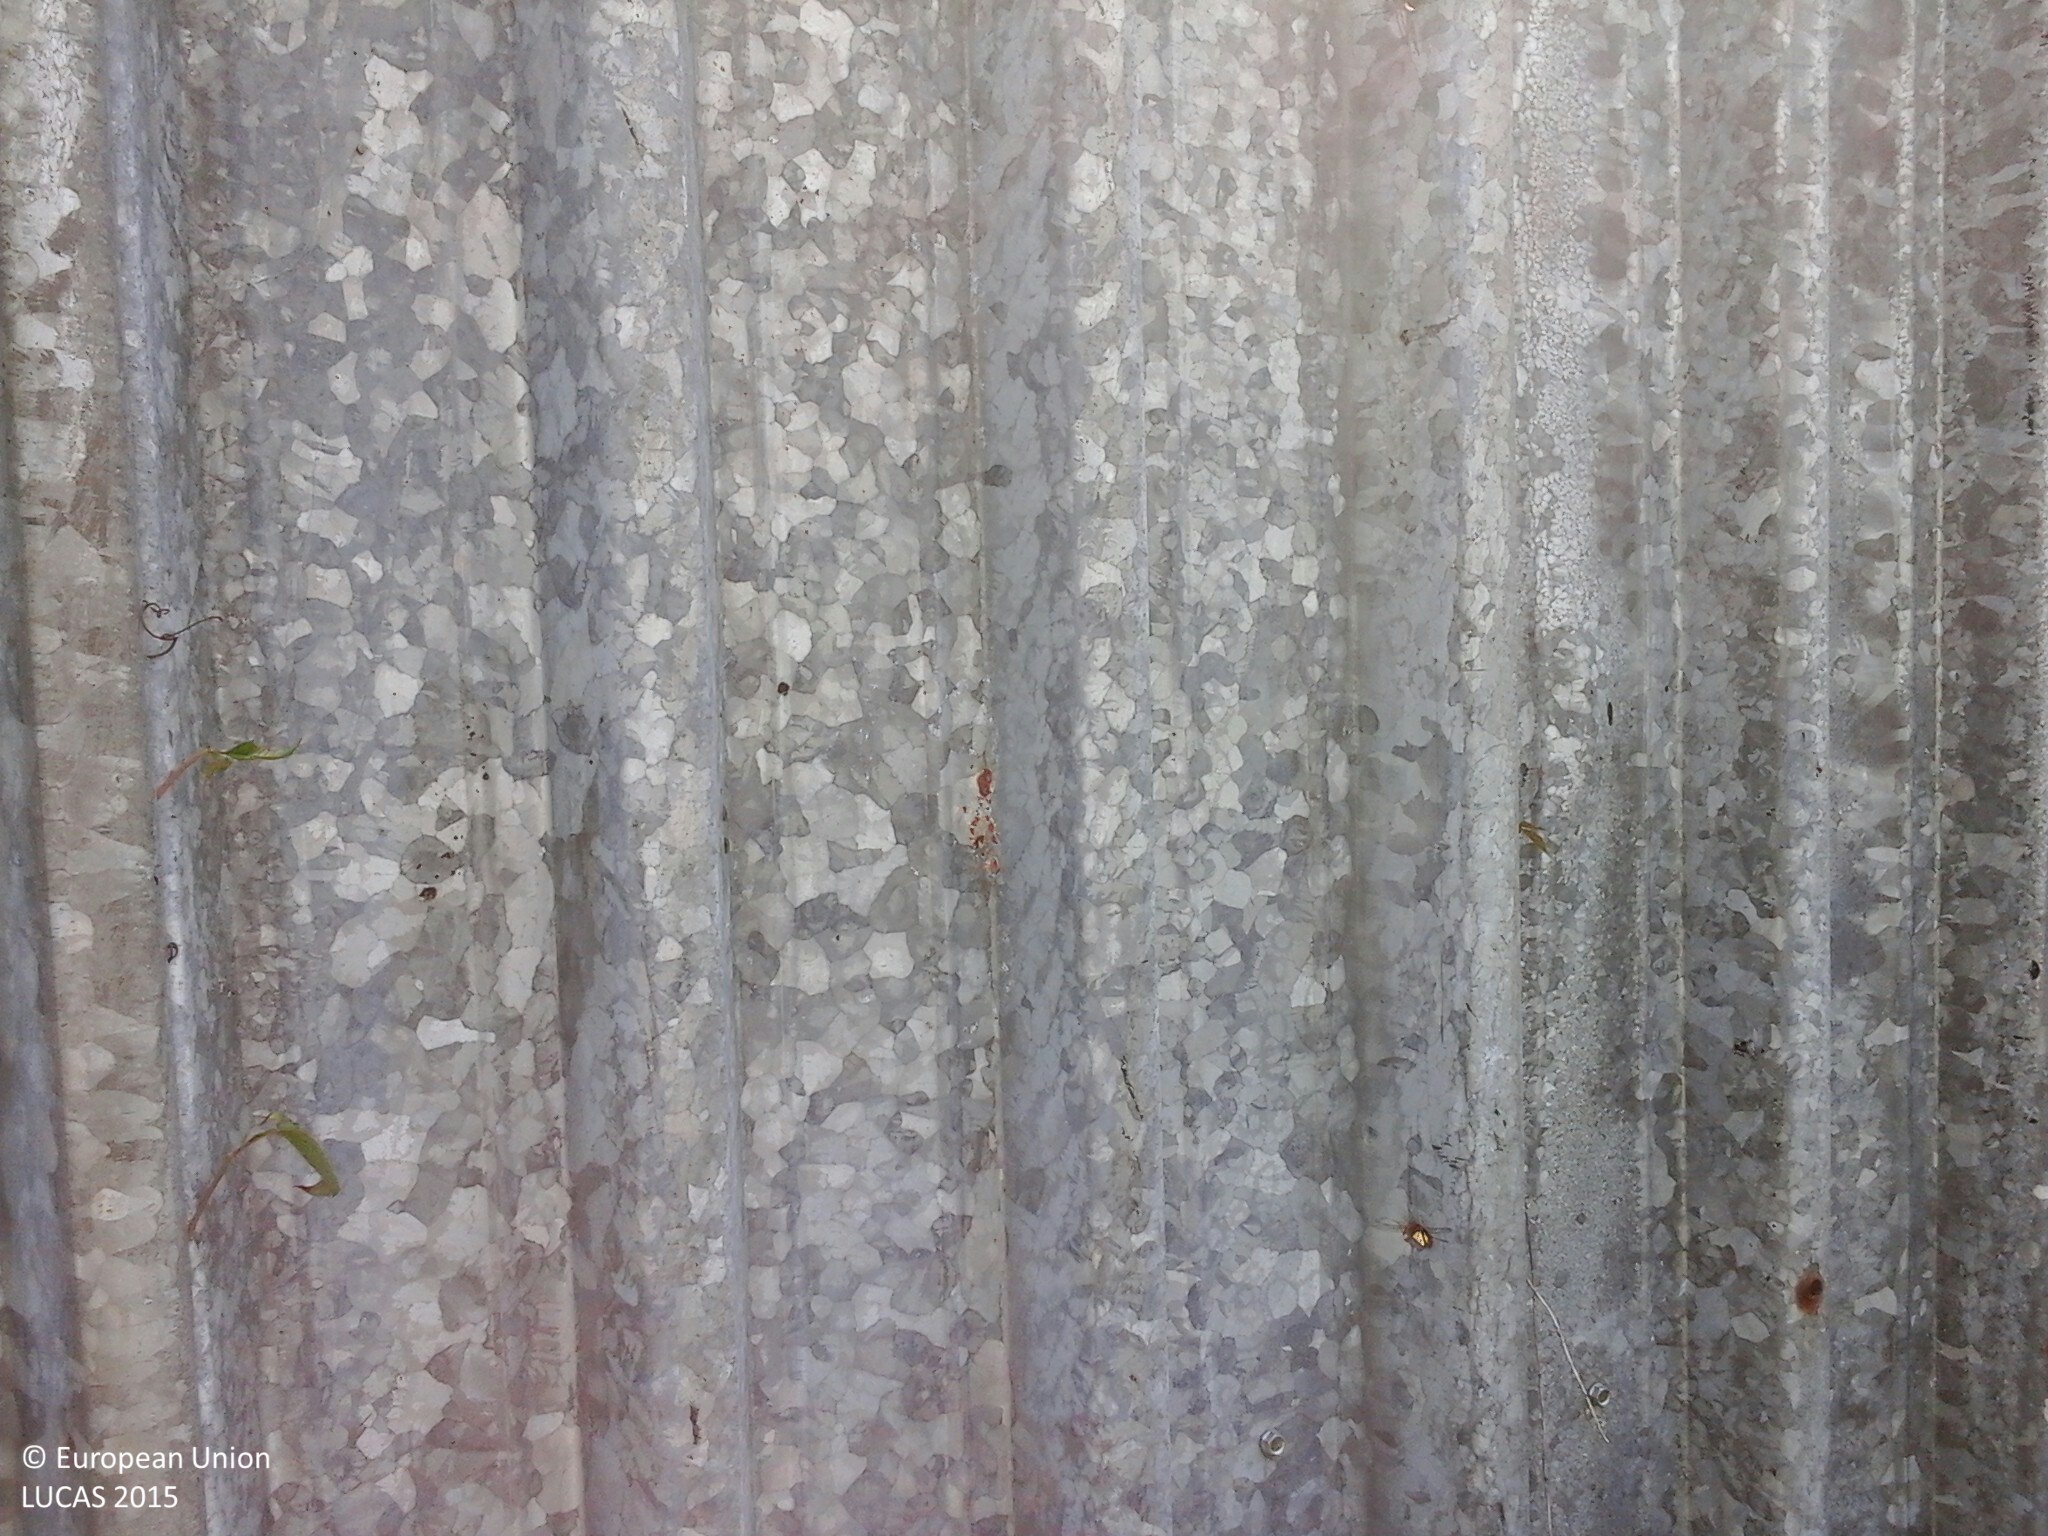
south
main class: Grassland
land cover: Grassland with sparse tree/shrub cover
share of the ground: > 75 %
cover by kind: herbaceous plants 95 %, broadleaved forest trees 5 %
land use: Semi-natural and natural areas not in use
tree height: < 5 m
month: August
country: HU
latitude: 48.1658
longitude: 20.3992
